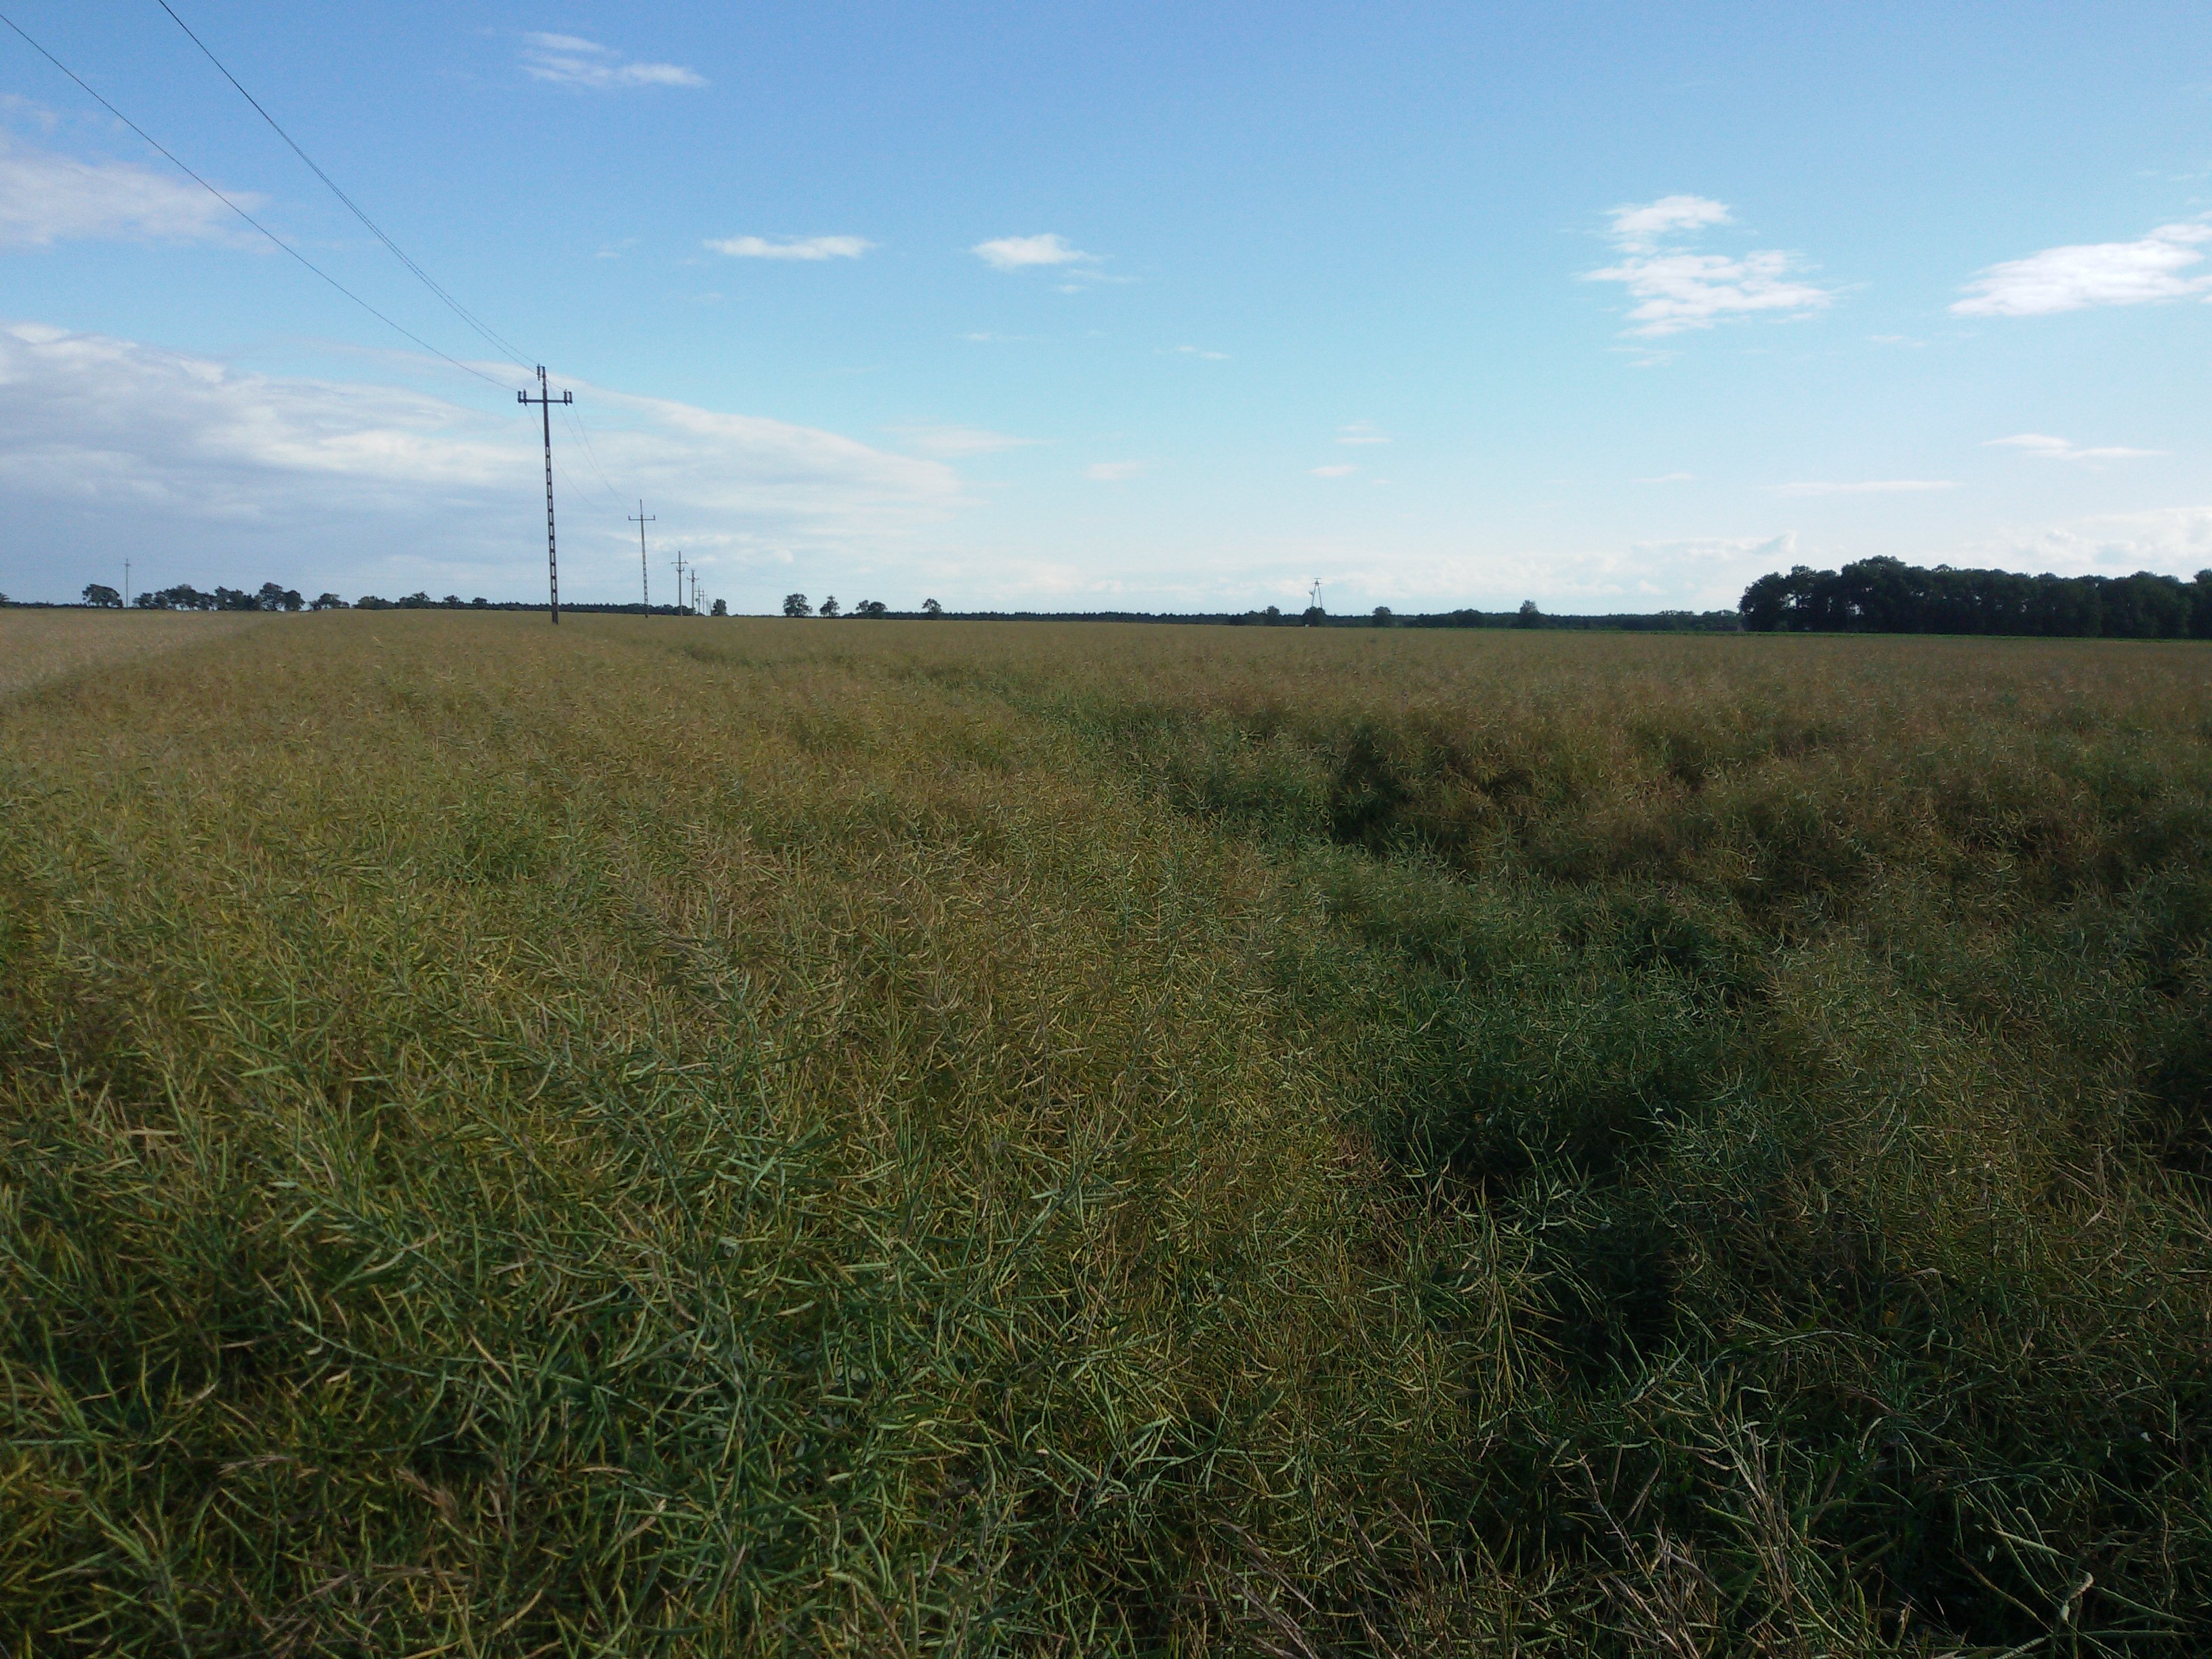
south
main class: Cropland
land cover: Rape and turnip rape
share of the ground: > 75 %
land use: Agriculture (excluding fallow land and kitchen gardens)
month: July
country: PL
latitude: 52.6613
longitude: 17.5382
